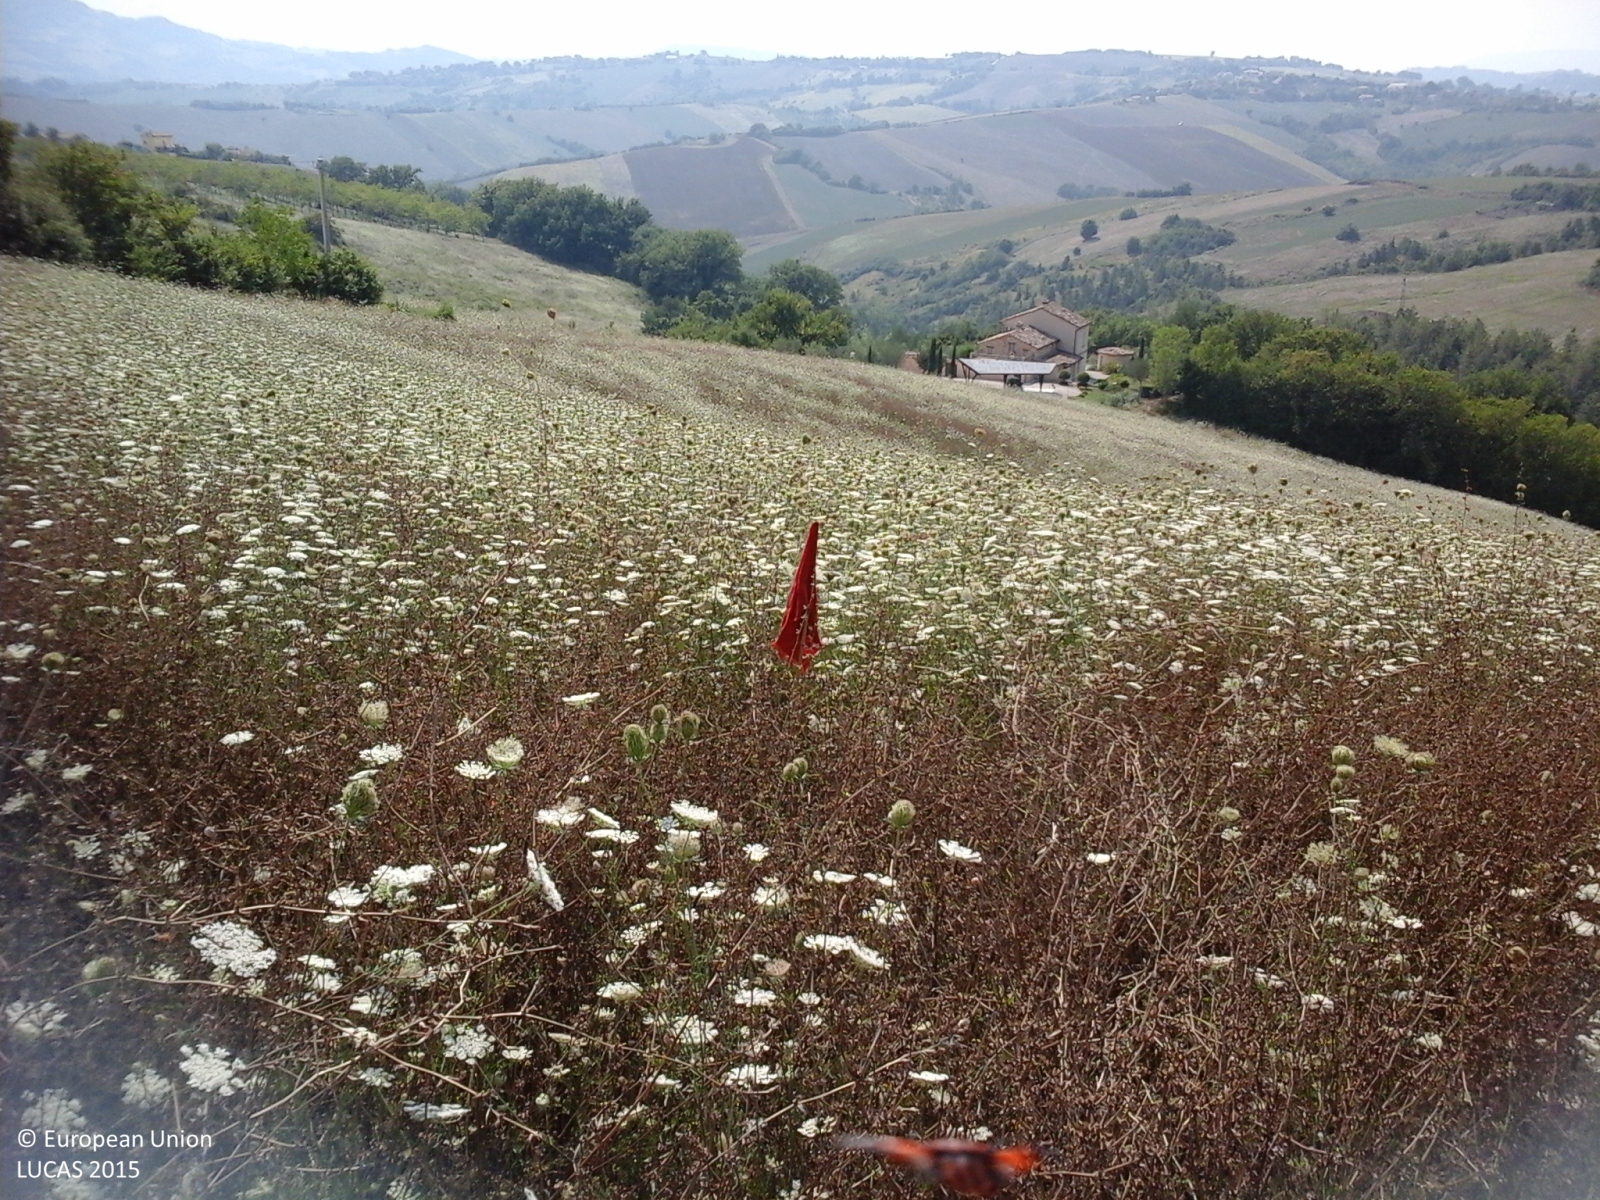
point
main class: Grassland
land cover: Spontaneously vegetated surfaces
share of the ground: > 75 %
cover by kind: herbaceous plants 100 %
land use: Fallow land
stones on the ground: < 10 %
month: August
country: IT
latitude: 43.1007
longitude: 13.4678
